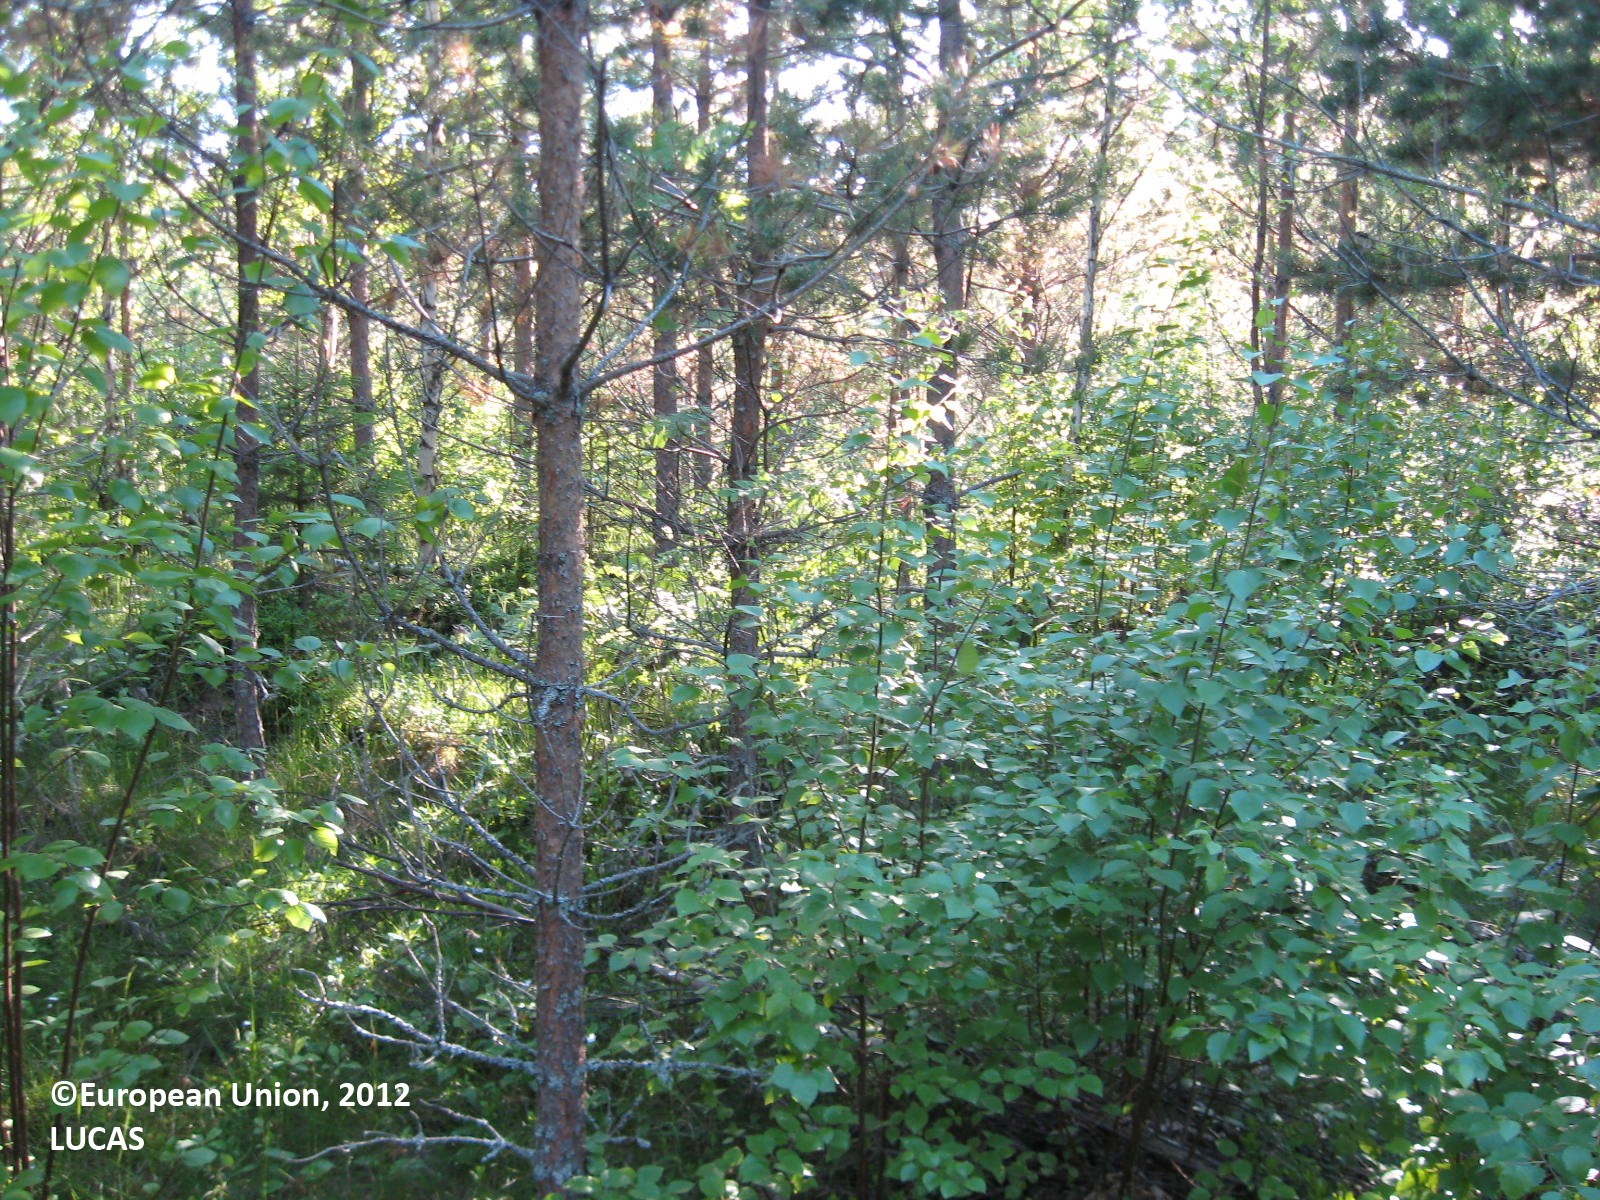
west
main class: Woodland
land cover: Pine dominated mixed woodland
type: boreal forest
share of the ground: > 75 %
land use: Forestry
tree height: > 5 m
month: June
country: FI
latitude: 62.8967
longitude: 21.7890
